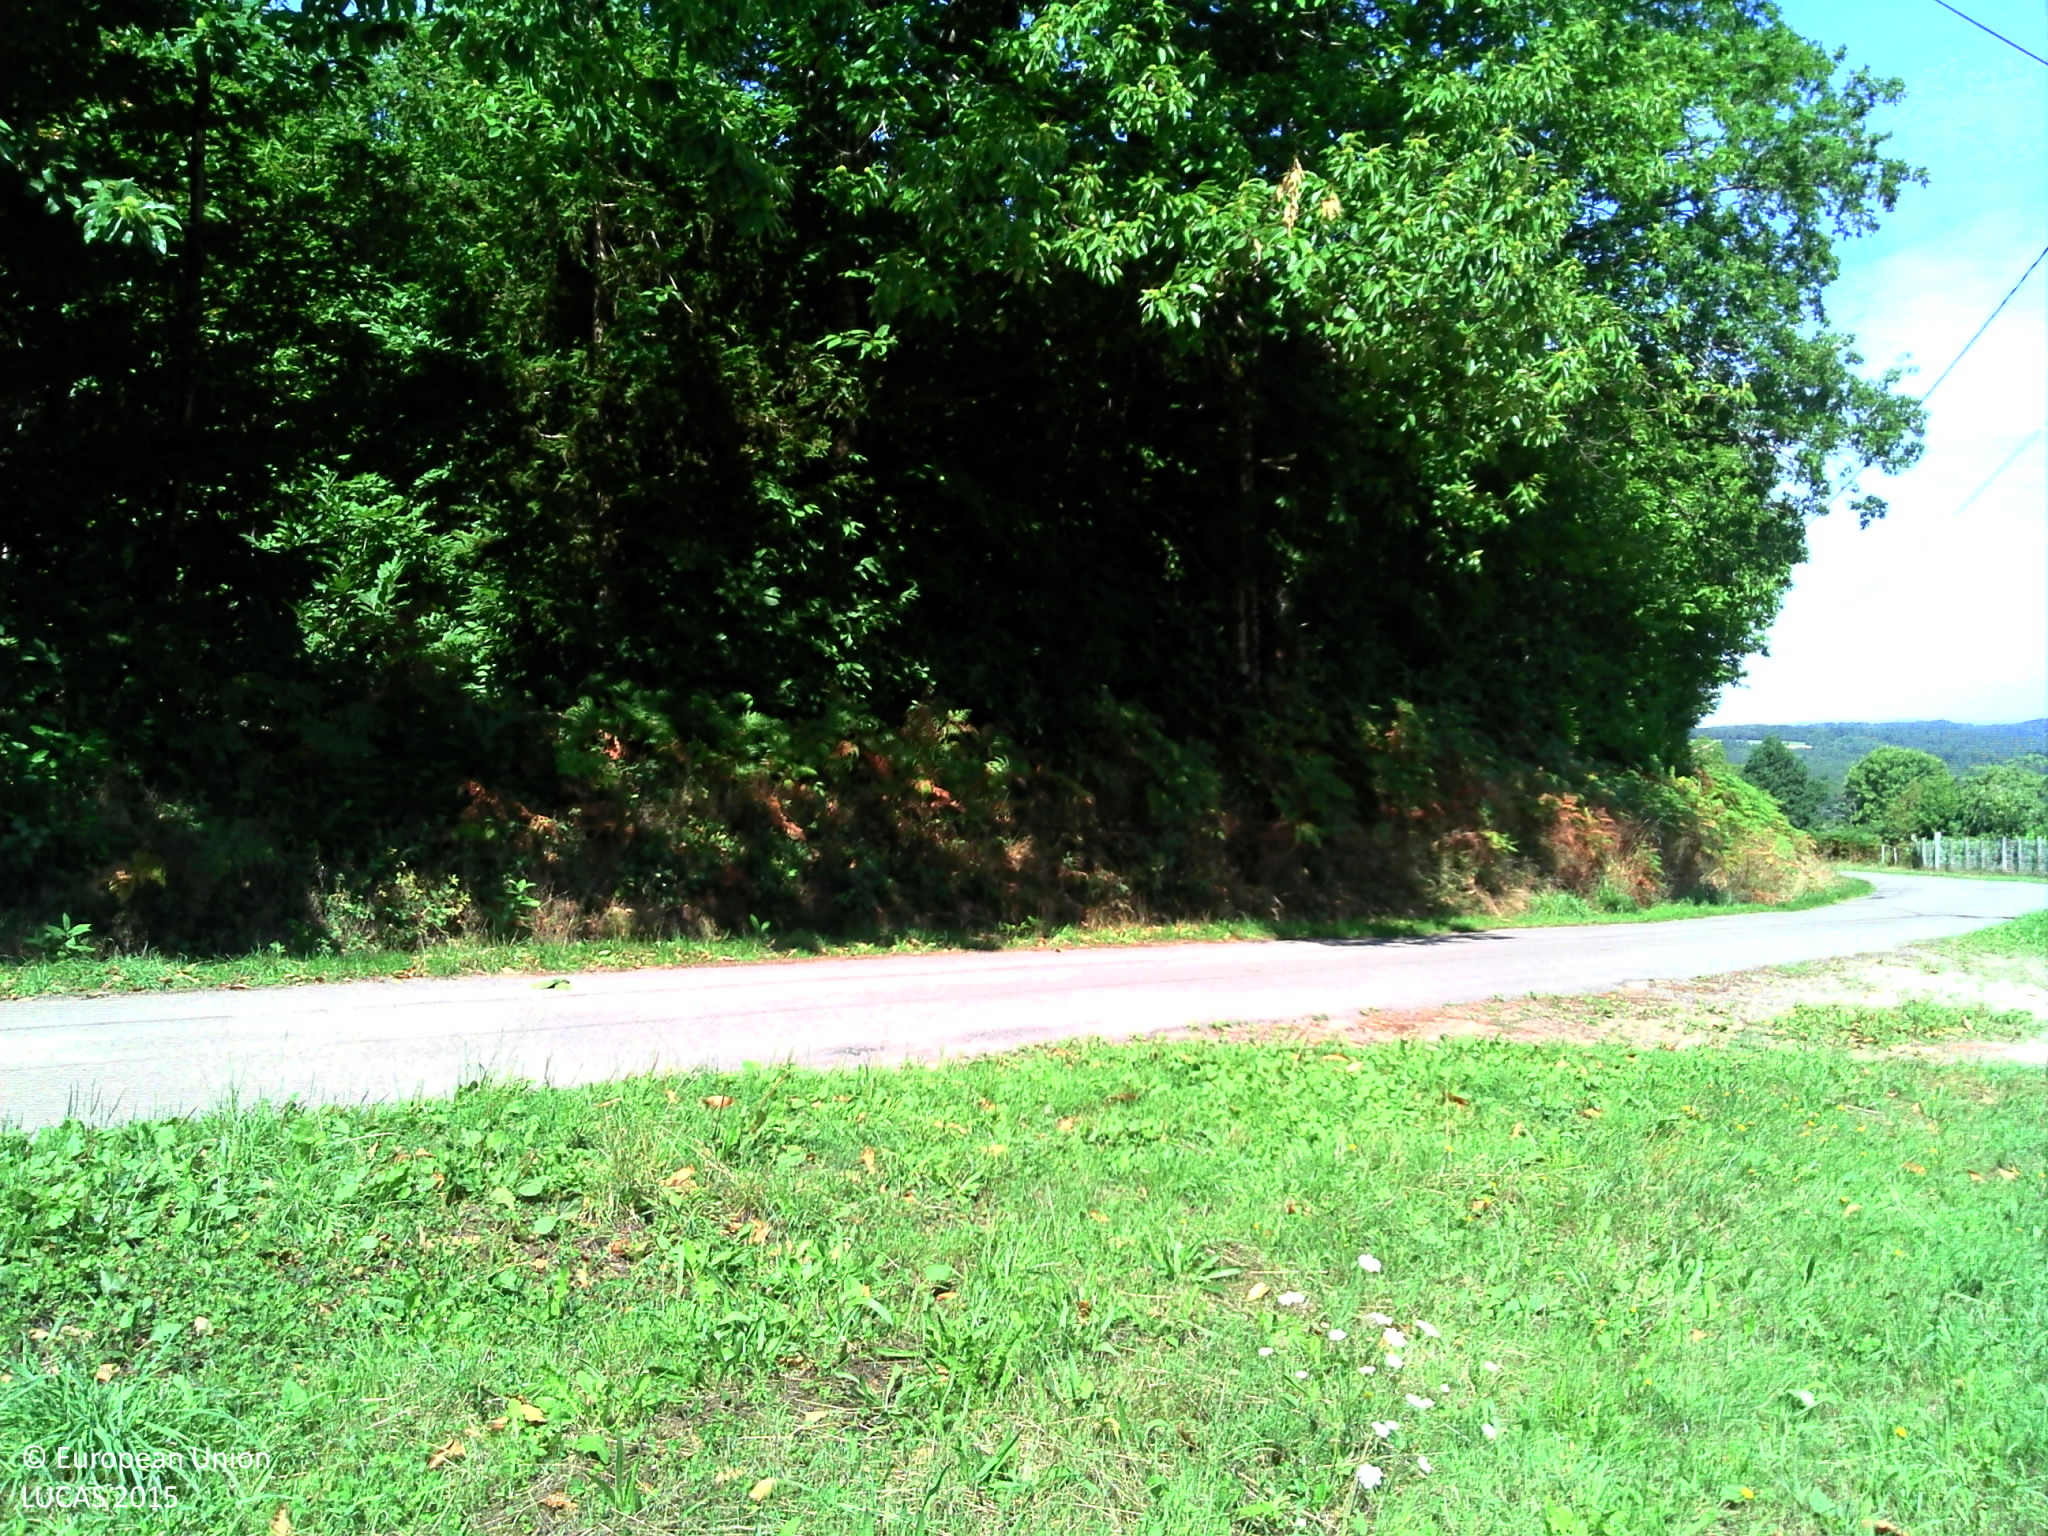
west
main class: Grassland
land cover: Spontaneously vegetated surfaces
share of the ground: > 75 %
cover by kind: herbaceous plants 95 %
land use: Agriculture (excluding fallow land and kitchen gardens)
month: August
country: FR
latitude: 45.6029
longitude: 1.3638
